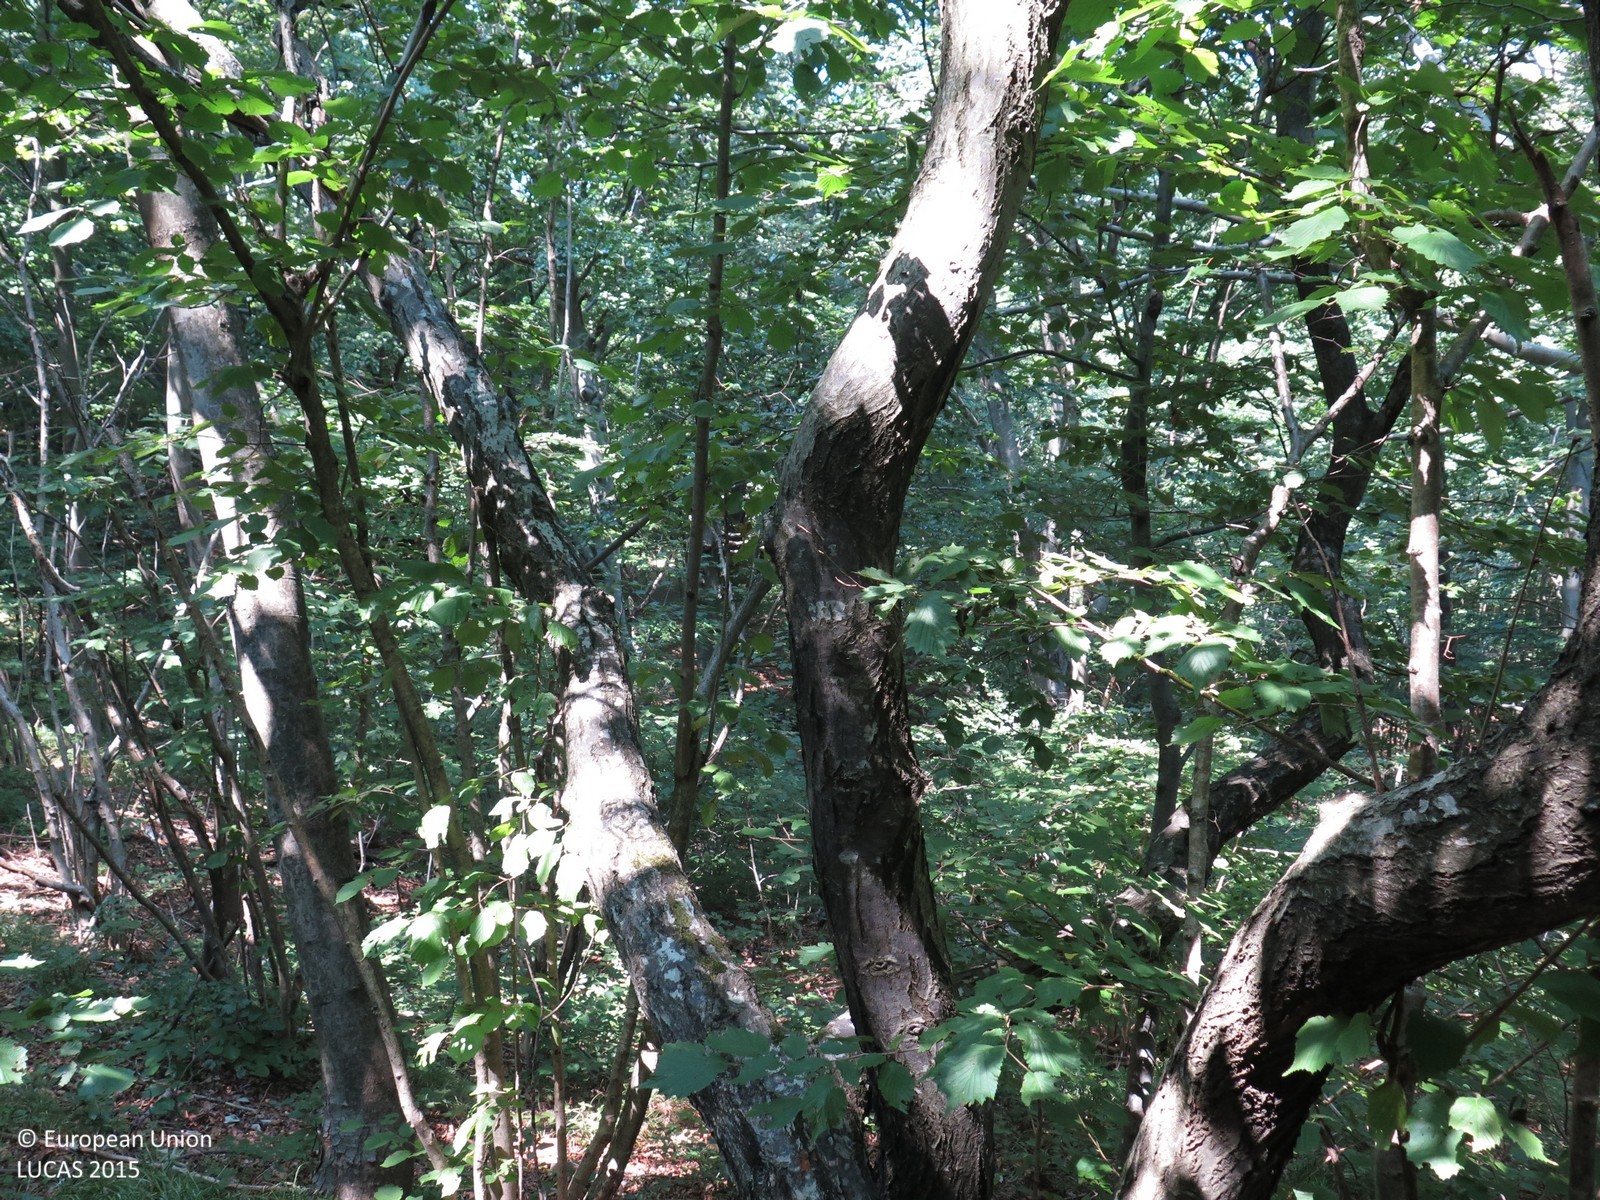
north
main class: Woodland
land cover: Broadleaved woodland
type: beech forest
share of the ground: > 75 %
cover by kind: broadleaved forest trees 90 %, herbaceous plants 5 %, unconsolidated bare surface 5 %
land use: Forestry
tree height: > 5 m
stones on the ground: 10 - 25 %
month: August
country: HR
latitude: 45.3679
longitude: 14.6043
